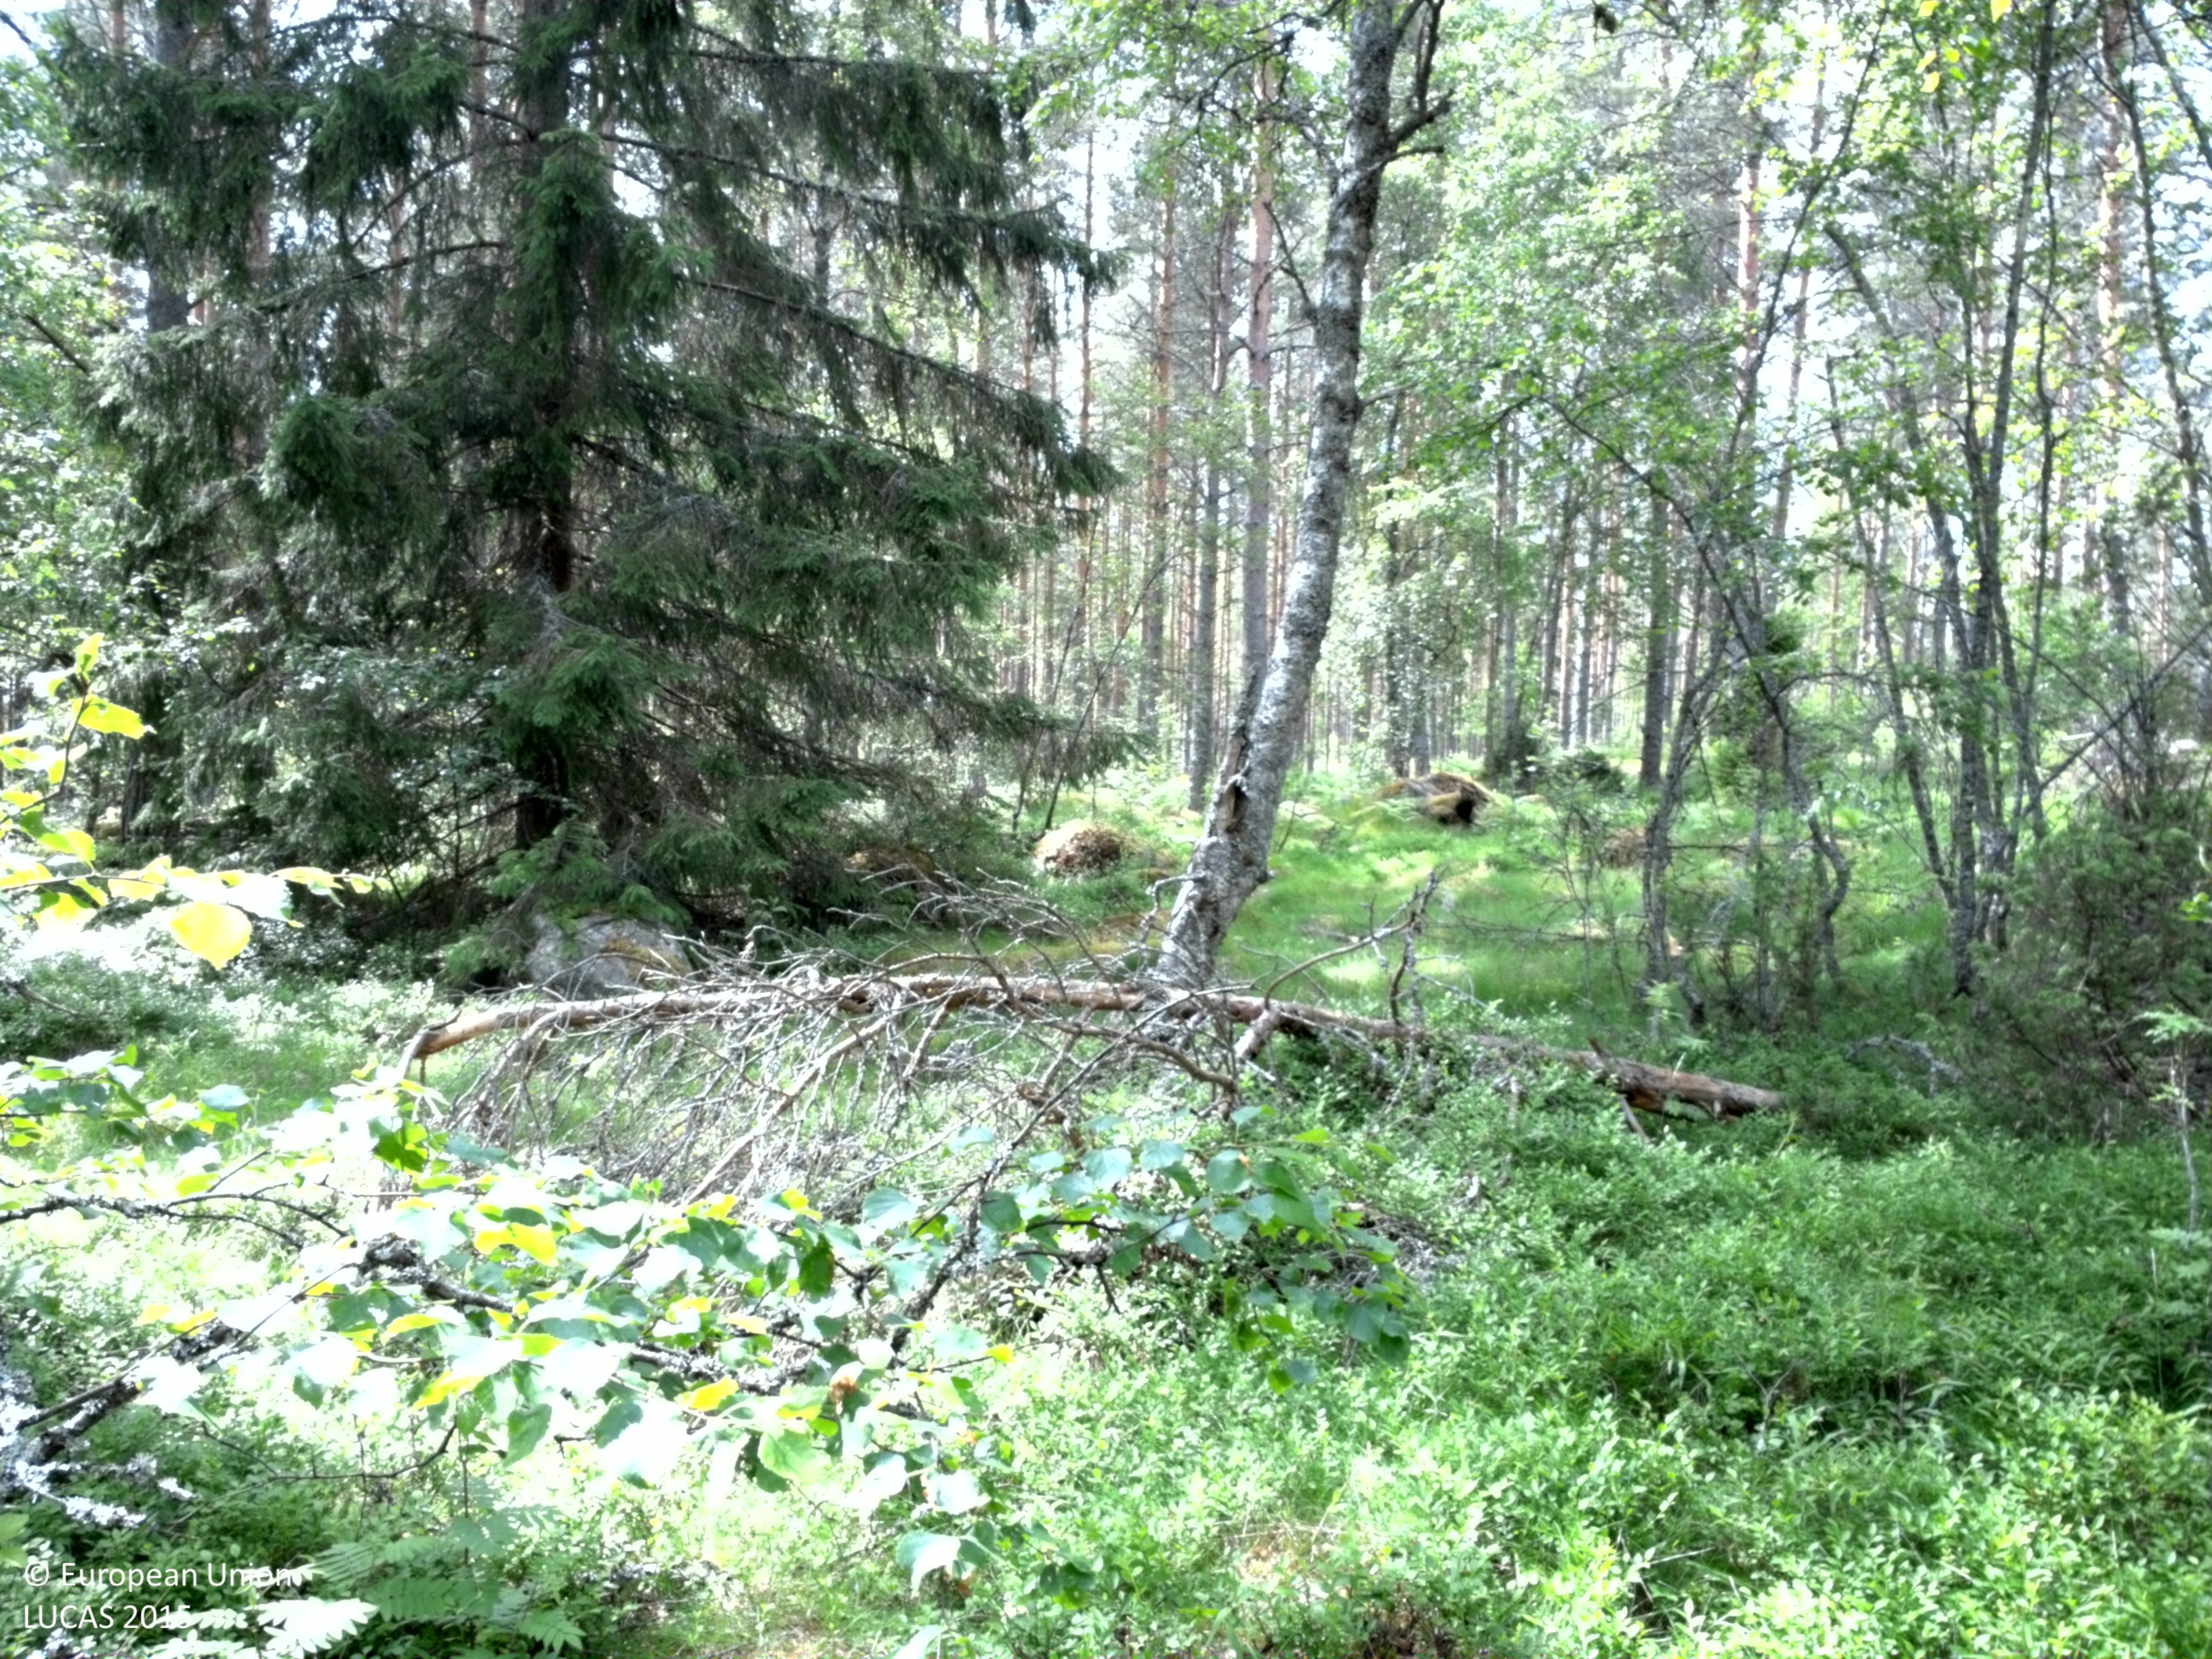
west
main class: Woodland
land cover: Broadleaved woodland
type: hemiboreal forest and nemoral coniferous forest and mixed broadleaved-coniferous forest
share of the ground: > 75 %
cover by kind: broadleaved forest trees 65 %, herbaceous plants 25 %, coniferous forest trees 10 %
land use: Forestry
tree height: > 5 m
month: June
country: SE
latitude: 59.9816
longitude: 17.1423
